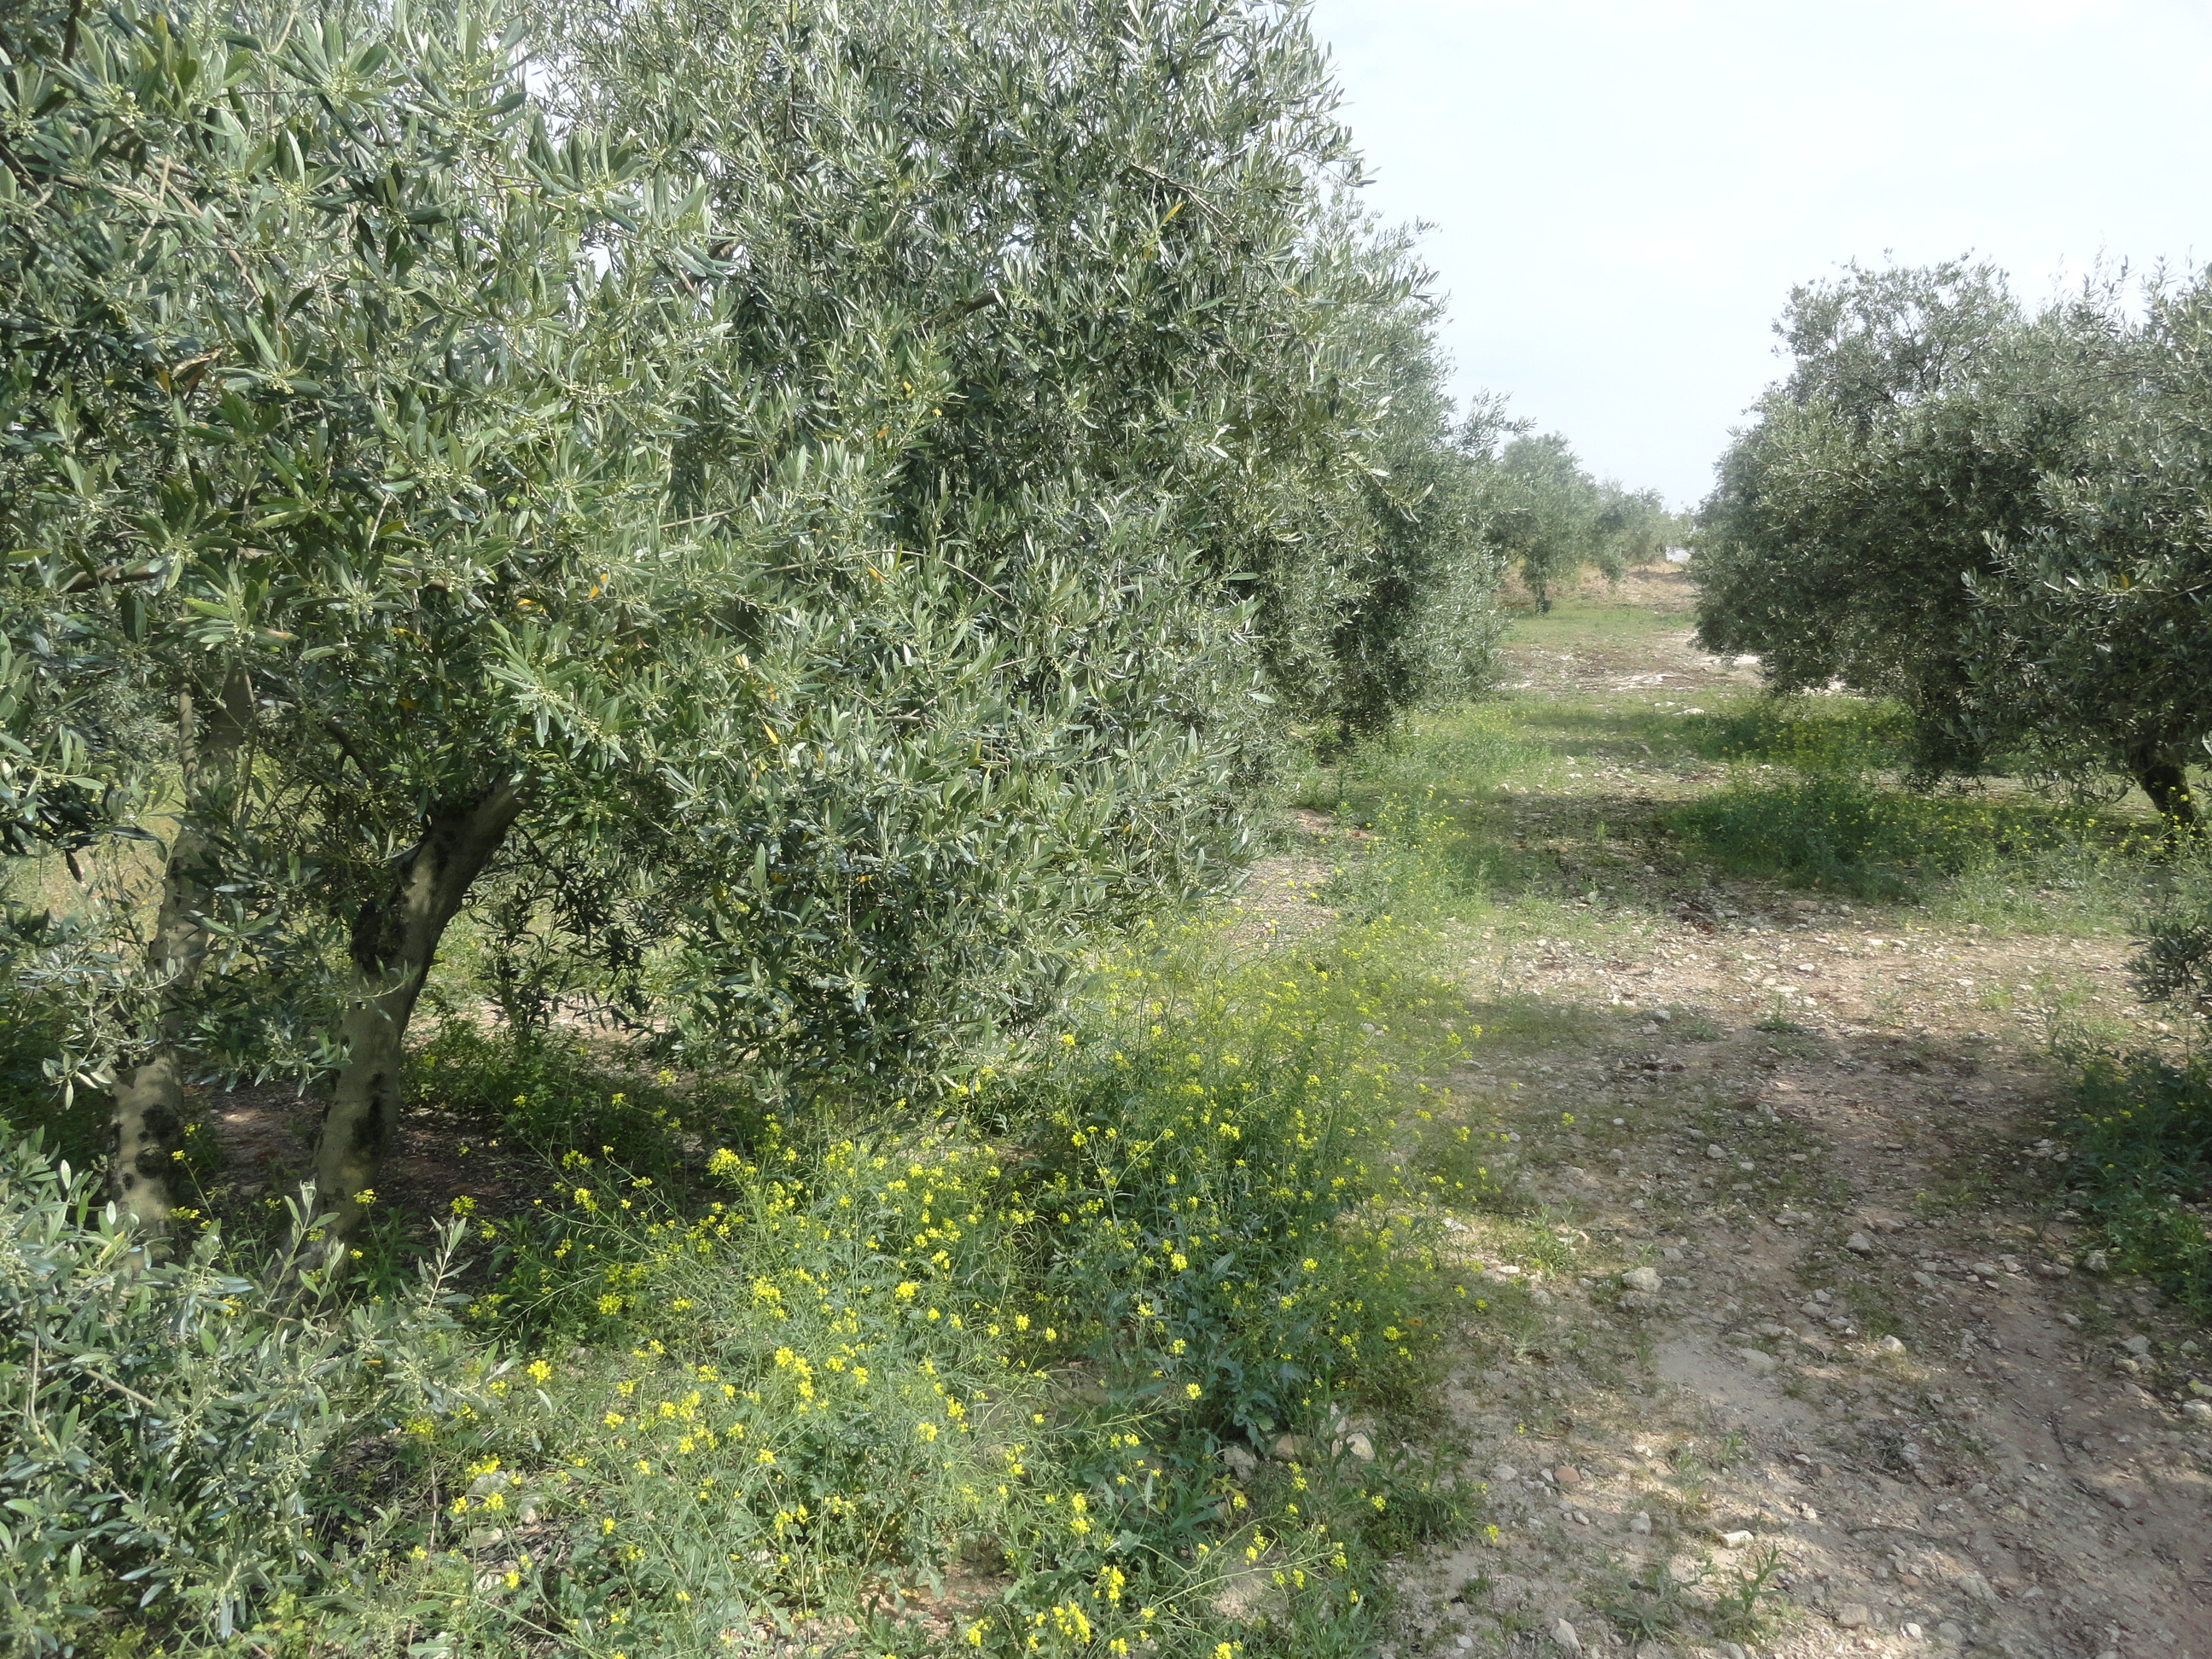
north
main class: Cropland
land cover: Olive groves
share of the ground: 50 - 75 %
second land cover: Spontaneously vegetated surfaces
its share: 25 - 50 %
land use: Agriculture (excluding fallow land and kitchen gardens)
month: April
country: ES
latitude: 37.4991
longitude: -4.5857
